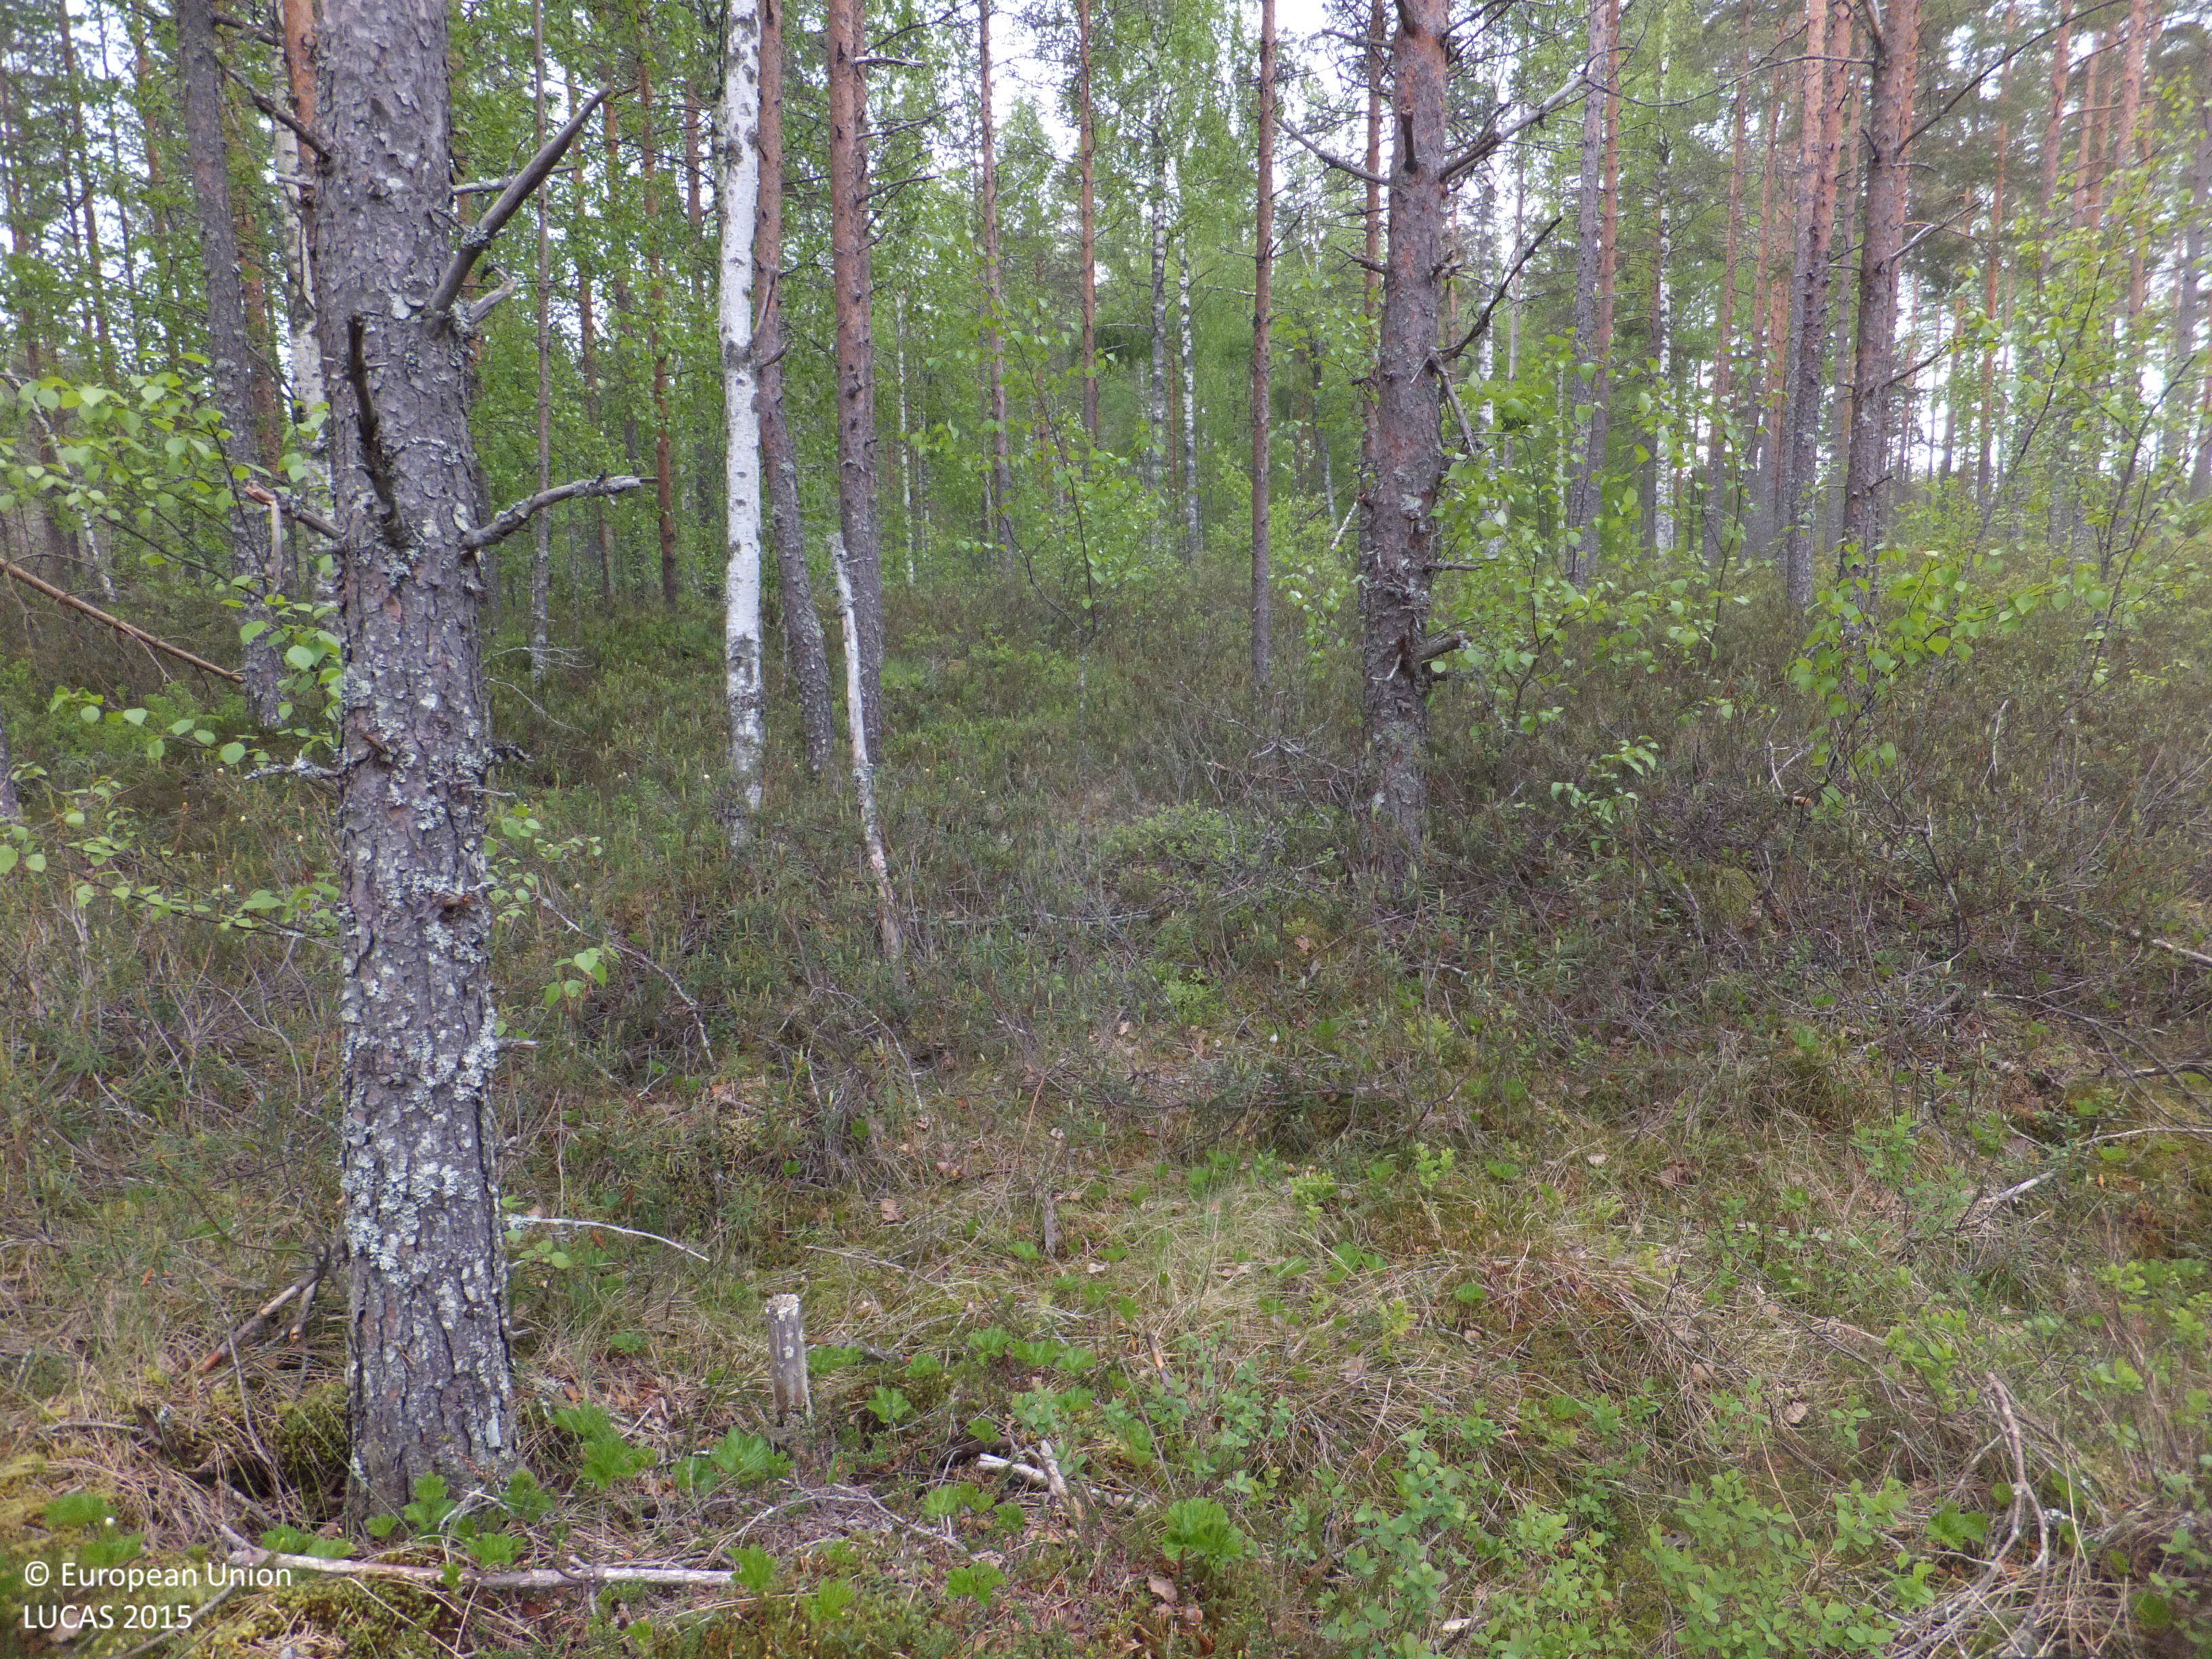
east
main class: Woodland
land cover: Pine dominated coniferous woodland
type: mire and swamp forests
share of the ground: > 75 %
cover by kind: coniferous forest trees 75 %, shrubs 15 %, herbaceous plants 10 %
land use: Forestry
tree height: > 5 m
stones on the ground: 10 - 25 %
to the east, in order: Pine dominated coniferous woodland; Pine dominated mixed woodland; Ditches and canals; Pine dominated mixed woodland; Ditches and canals; Pine dominated coniferous woodland; Ditches and canals; Pine dominated coniferous woodland; Pine dominated mixed woodland; Ditches and canals; Pine dominated mixed woodland; Ditches and canals; Pine dominated mixed woodland; Pine dominated coniferous woodland; Ditches and canals; Pine dominated coniferous woodland
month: June
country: FI
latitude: 63.6073
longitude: 24.2078
